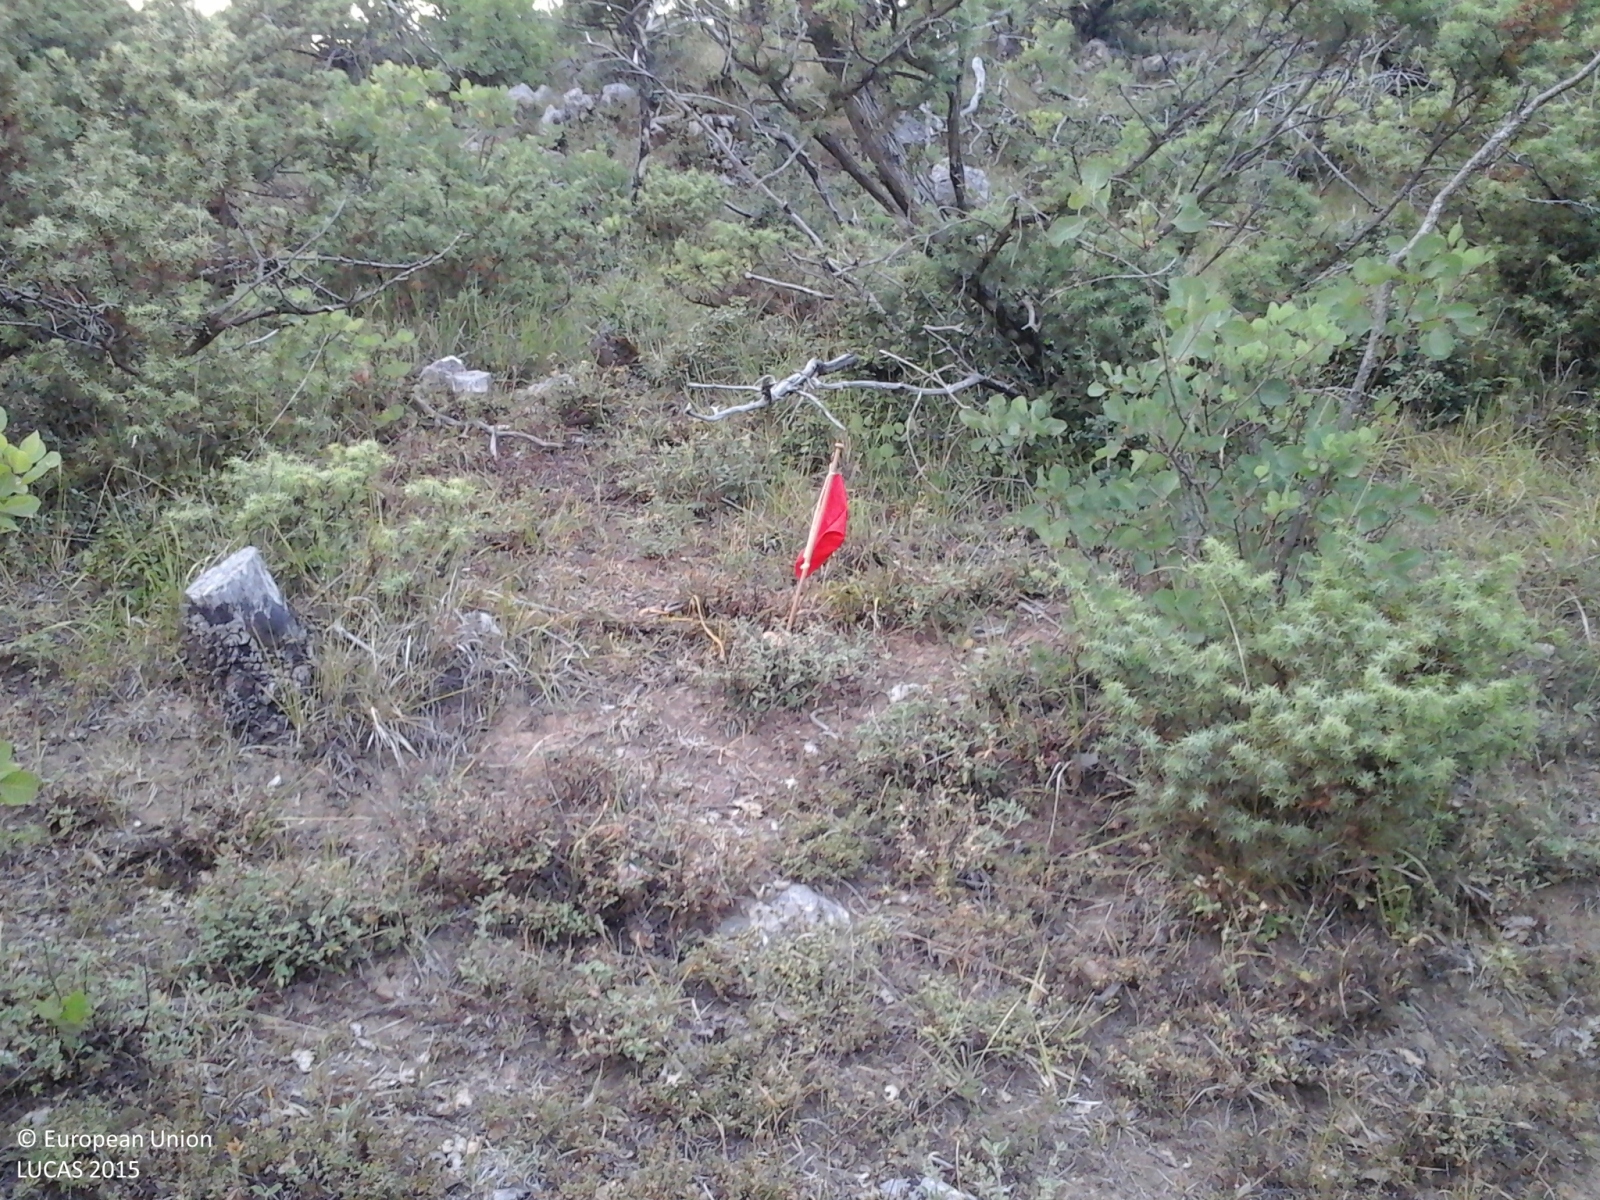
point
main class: Shrubland
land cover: Shrubland with sparse tree cover
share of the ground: > 75 %
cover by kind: shrubs 70 %, herbaceous plants 15 %, unconsolidated bare surface 10 %, broadleaved forest trees 5 %
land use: Agriculture (excluding fallow land and kitchen gardens)
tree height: > 5 m
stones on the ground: 10 - 25 %
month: July
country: GR
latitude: 40.0496
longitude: 20.6598
